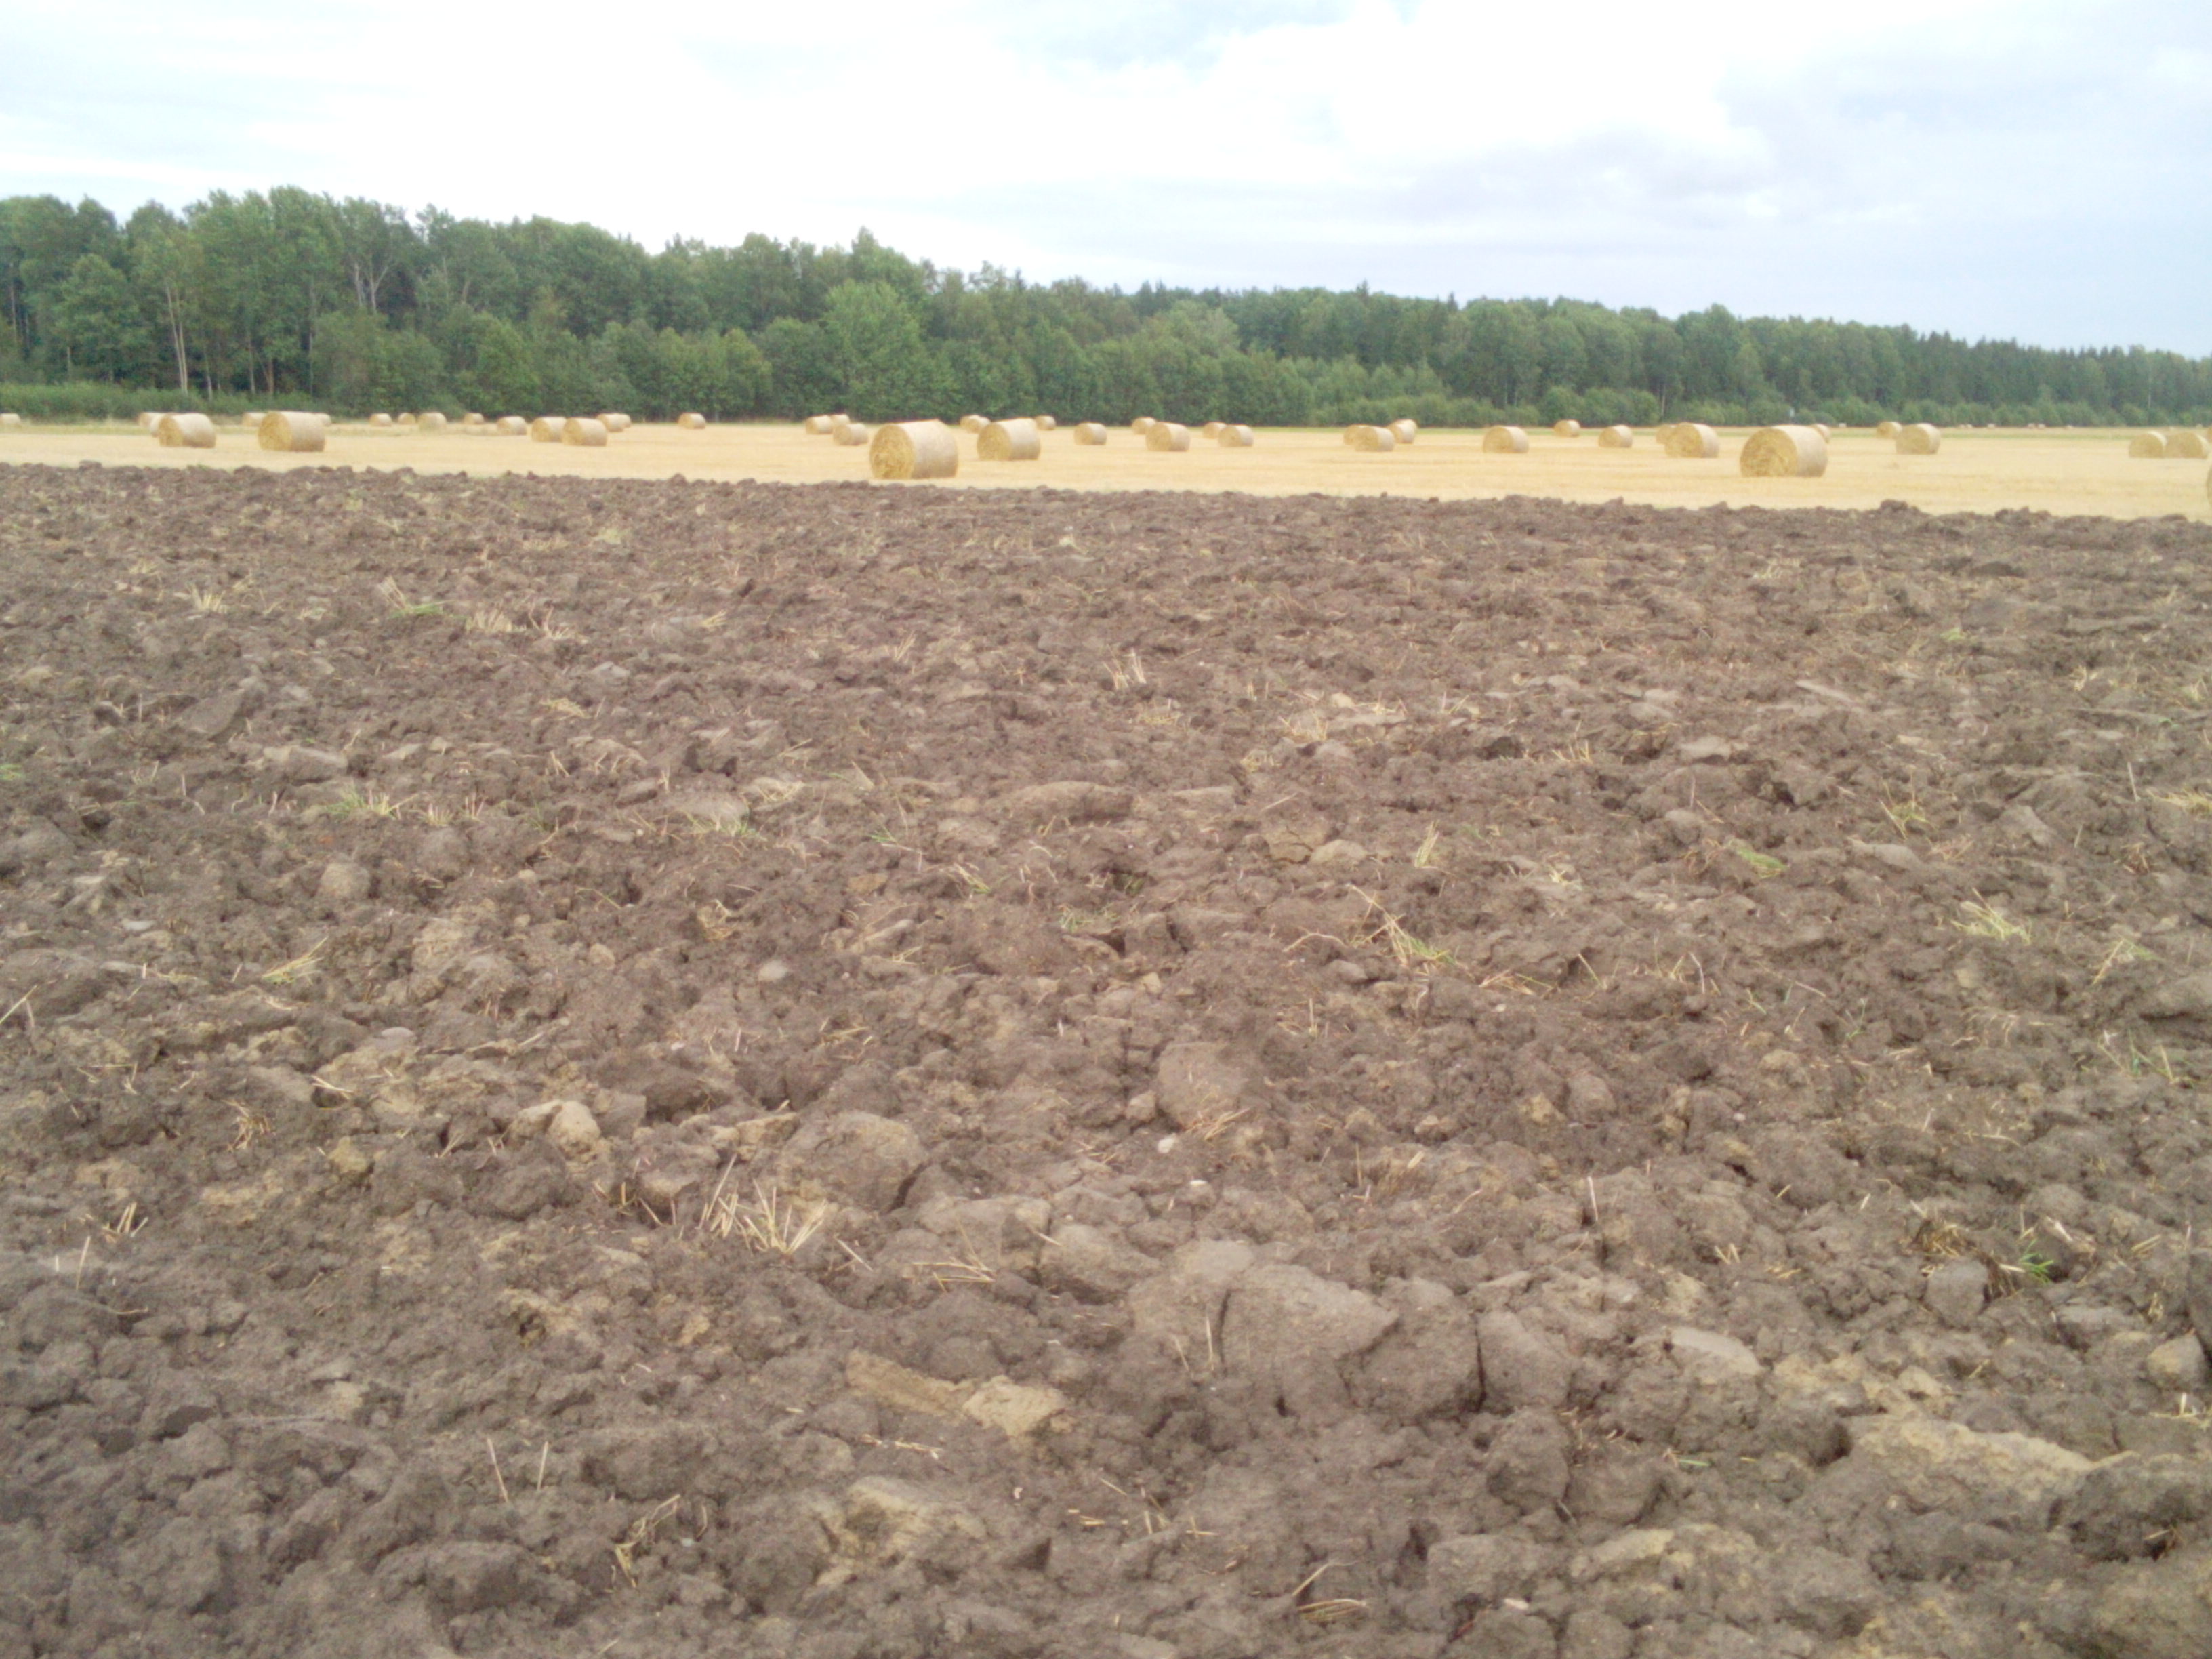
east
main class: Cropland
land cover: Barley
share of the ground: < 10 %
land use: Agriculture (excluding fallow land and kitchen gardens)
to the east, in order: Barley; Common wheat; Grassland without tree/shrub cover
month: September
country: LT
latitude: 55.9016
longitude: 22.6820
